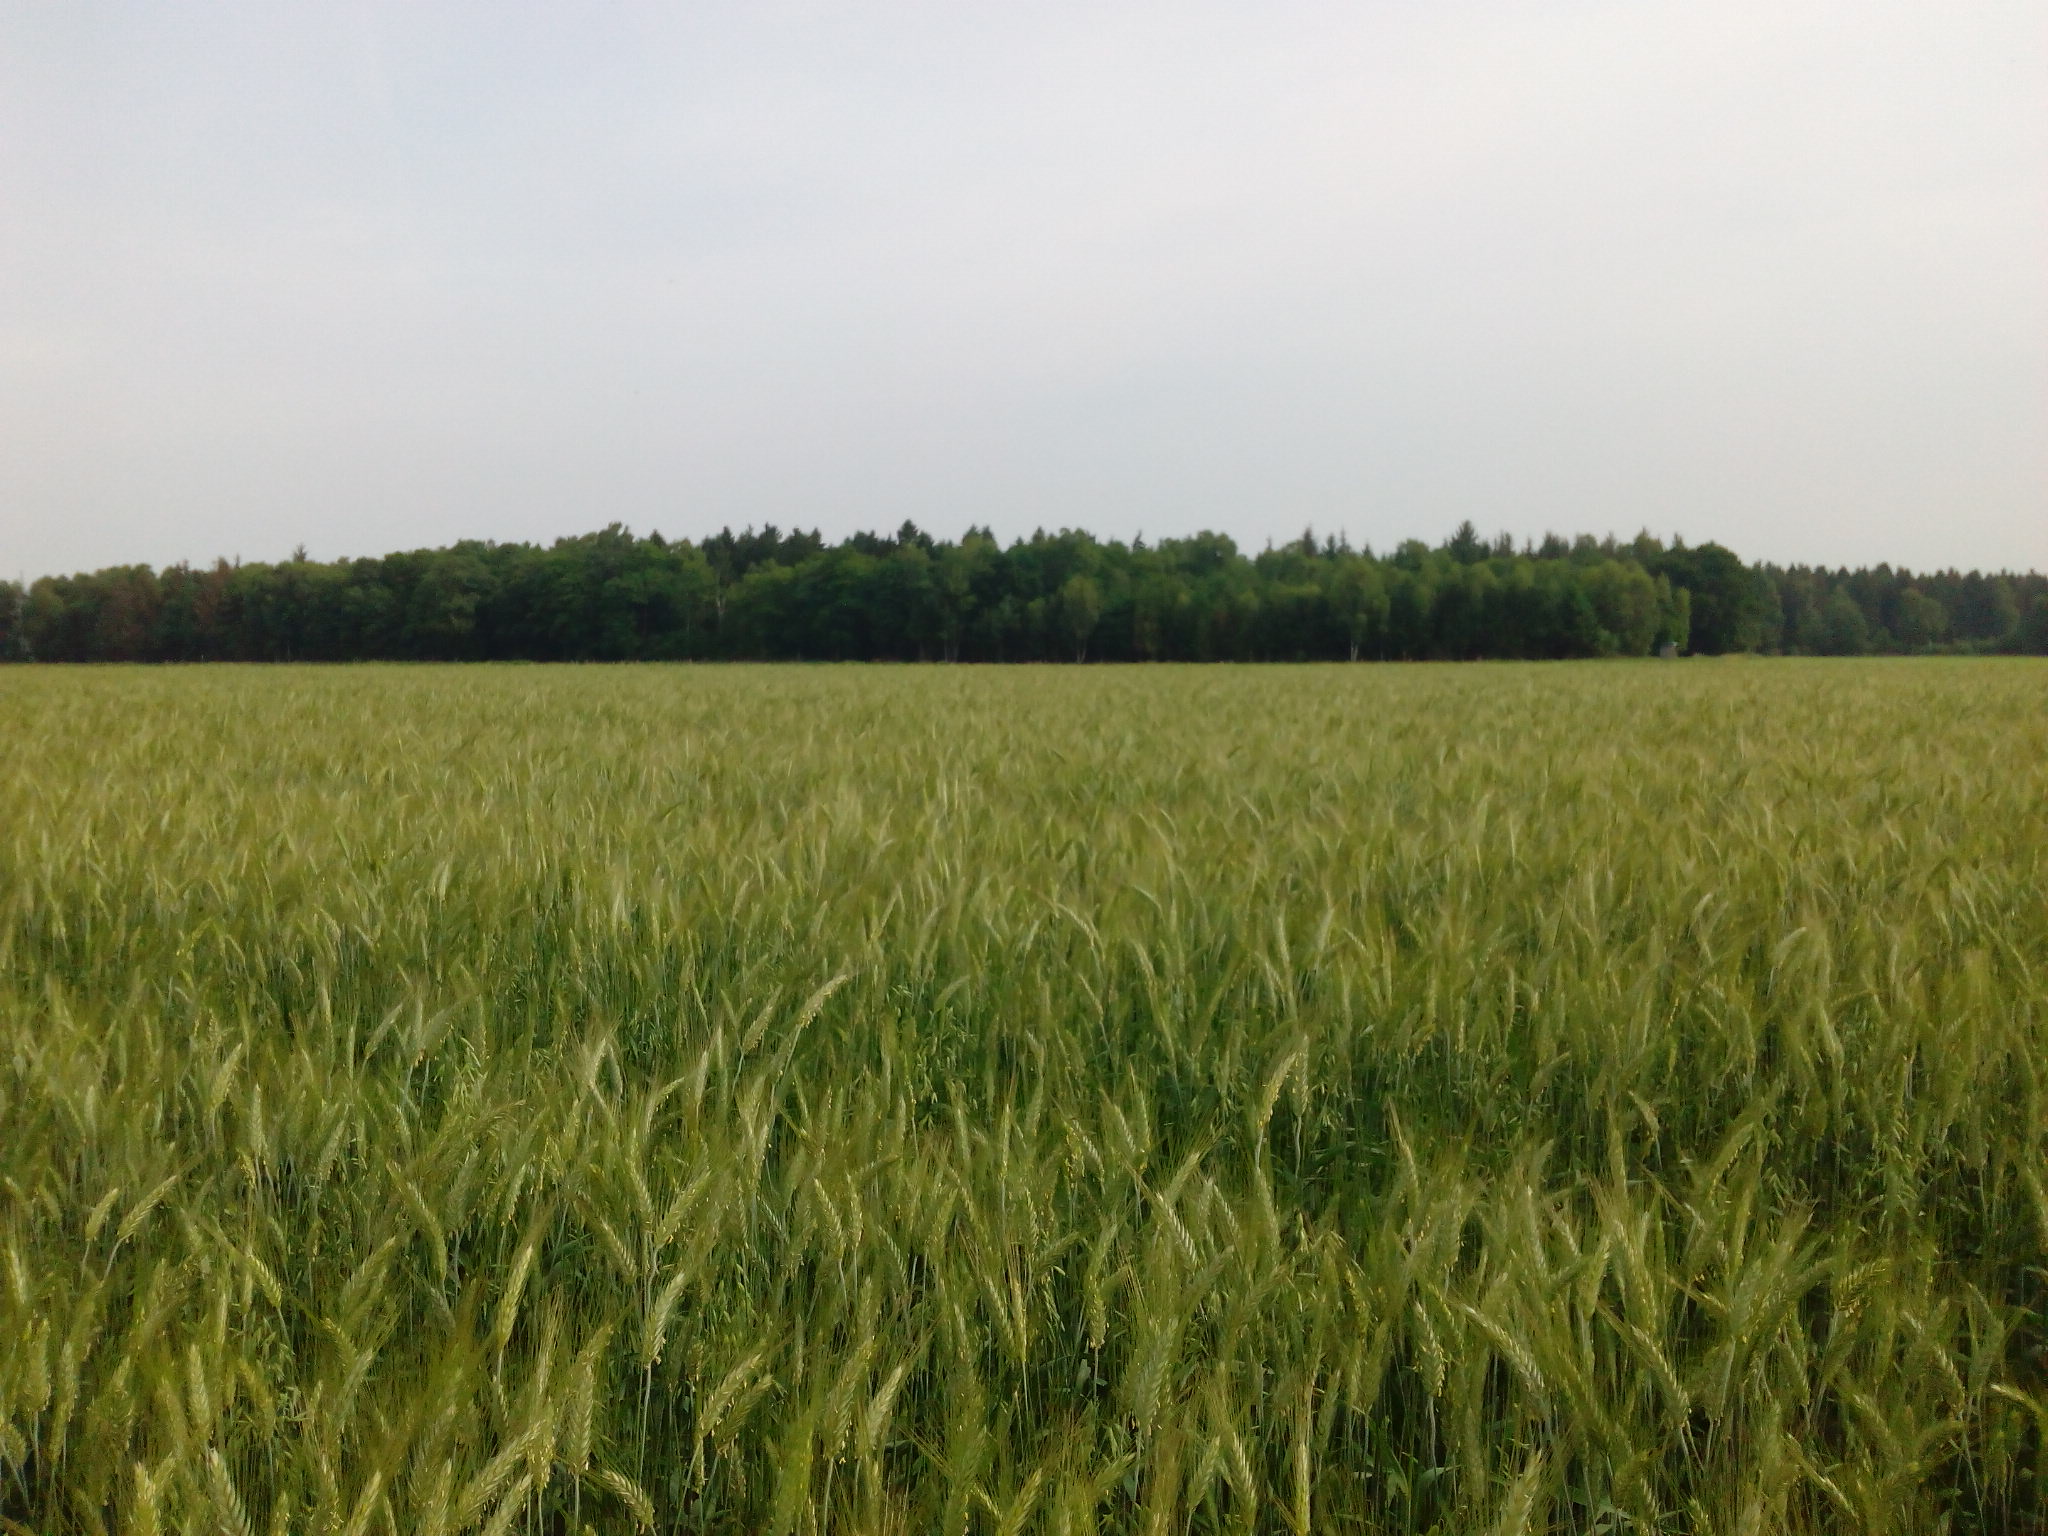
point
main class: Cropland
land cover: Rye
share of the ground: > 75 %
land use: Agriculture (excluding fallow land and kitchen gardens)
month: June
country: DE
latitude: 52.7543
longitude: 9.6297
